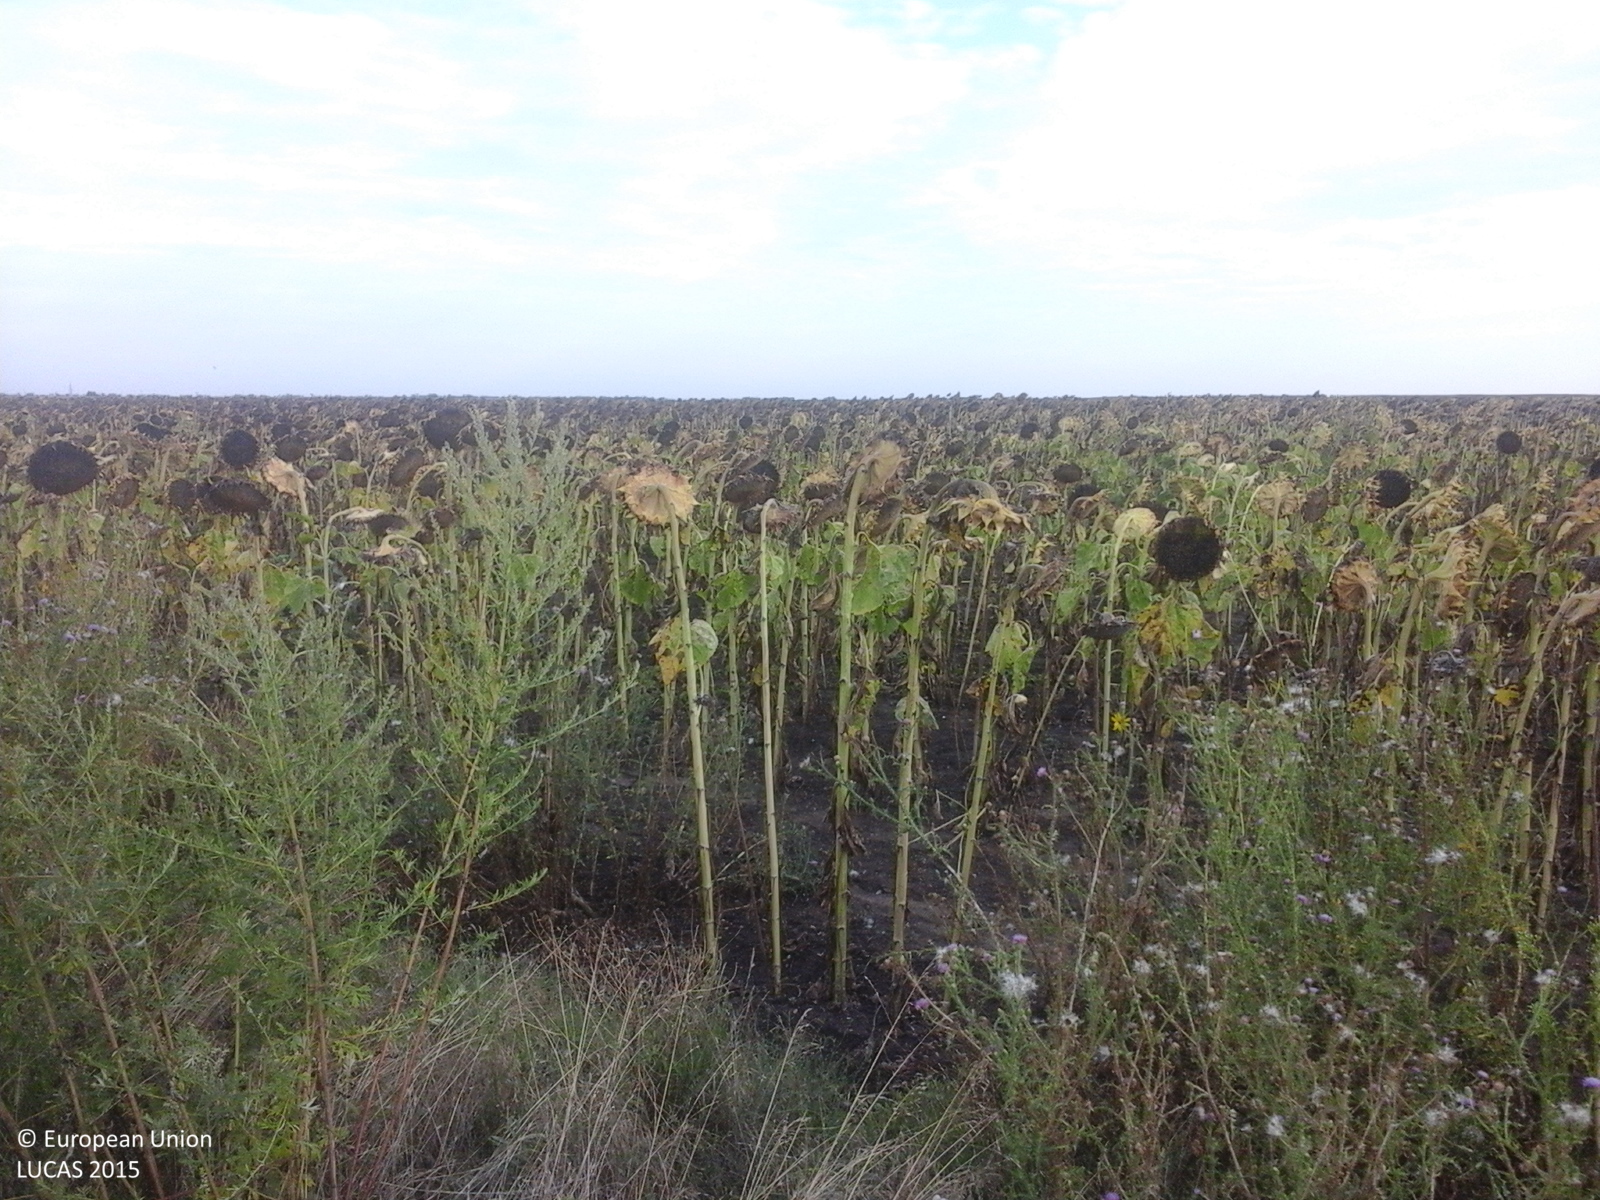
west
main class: Cropland
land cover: Sunflower
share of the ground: > 75 %
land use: Agriculture (excluding fallow land and kitchen gardens)
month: August
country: RO
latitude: 46.2886
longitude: 21.3667
